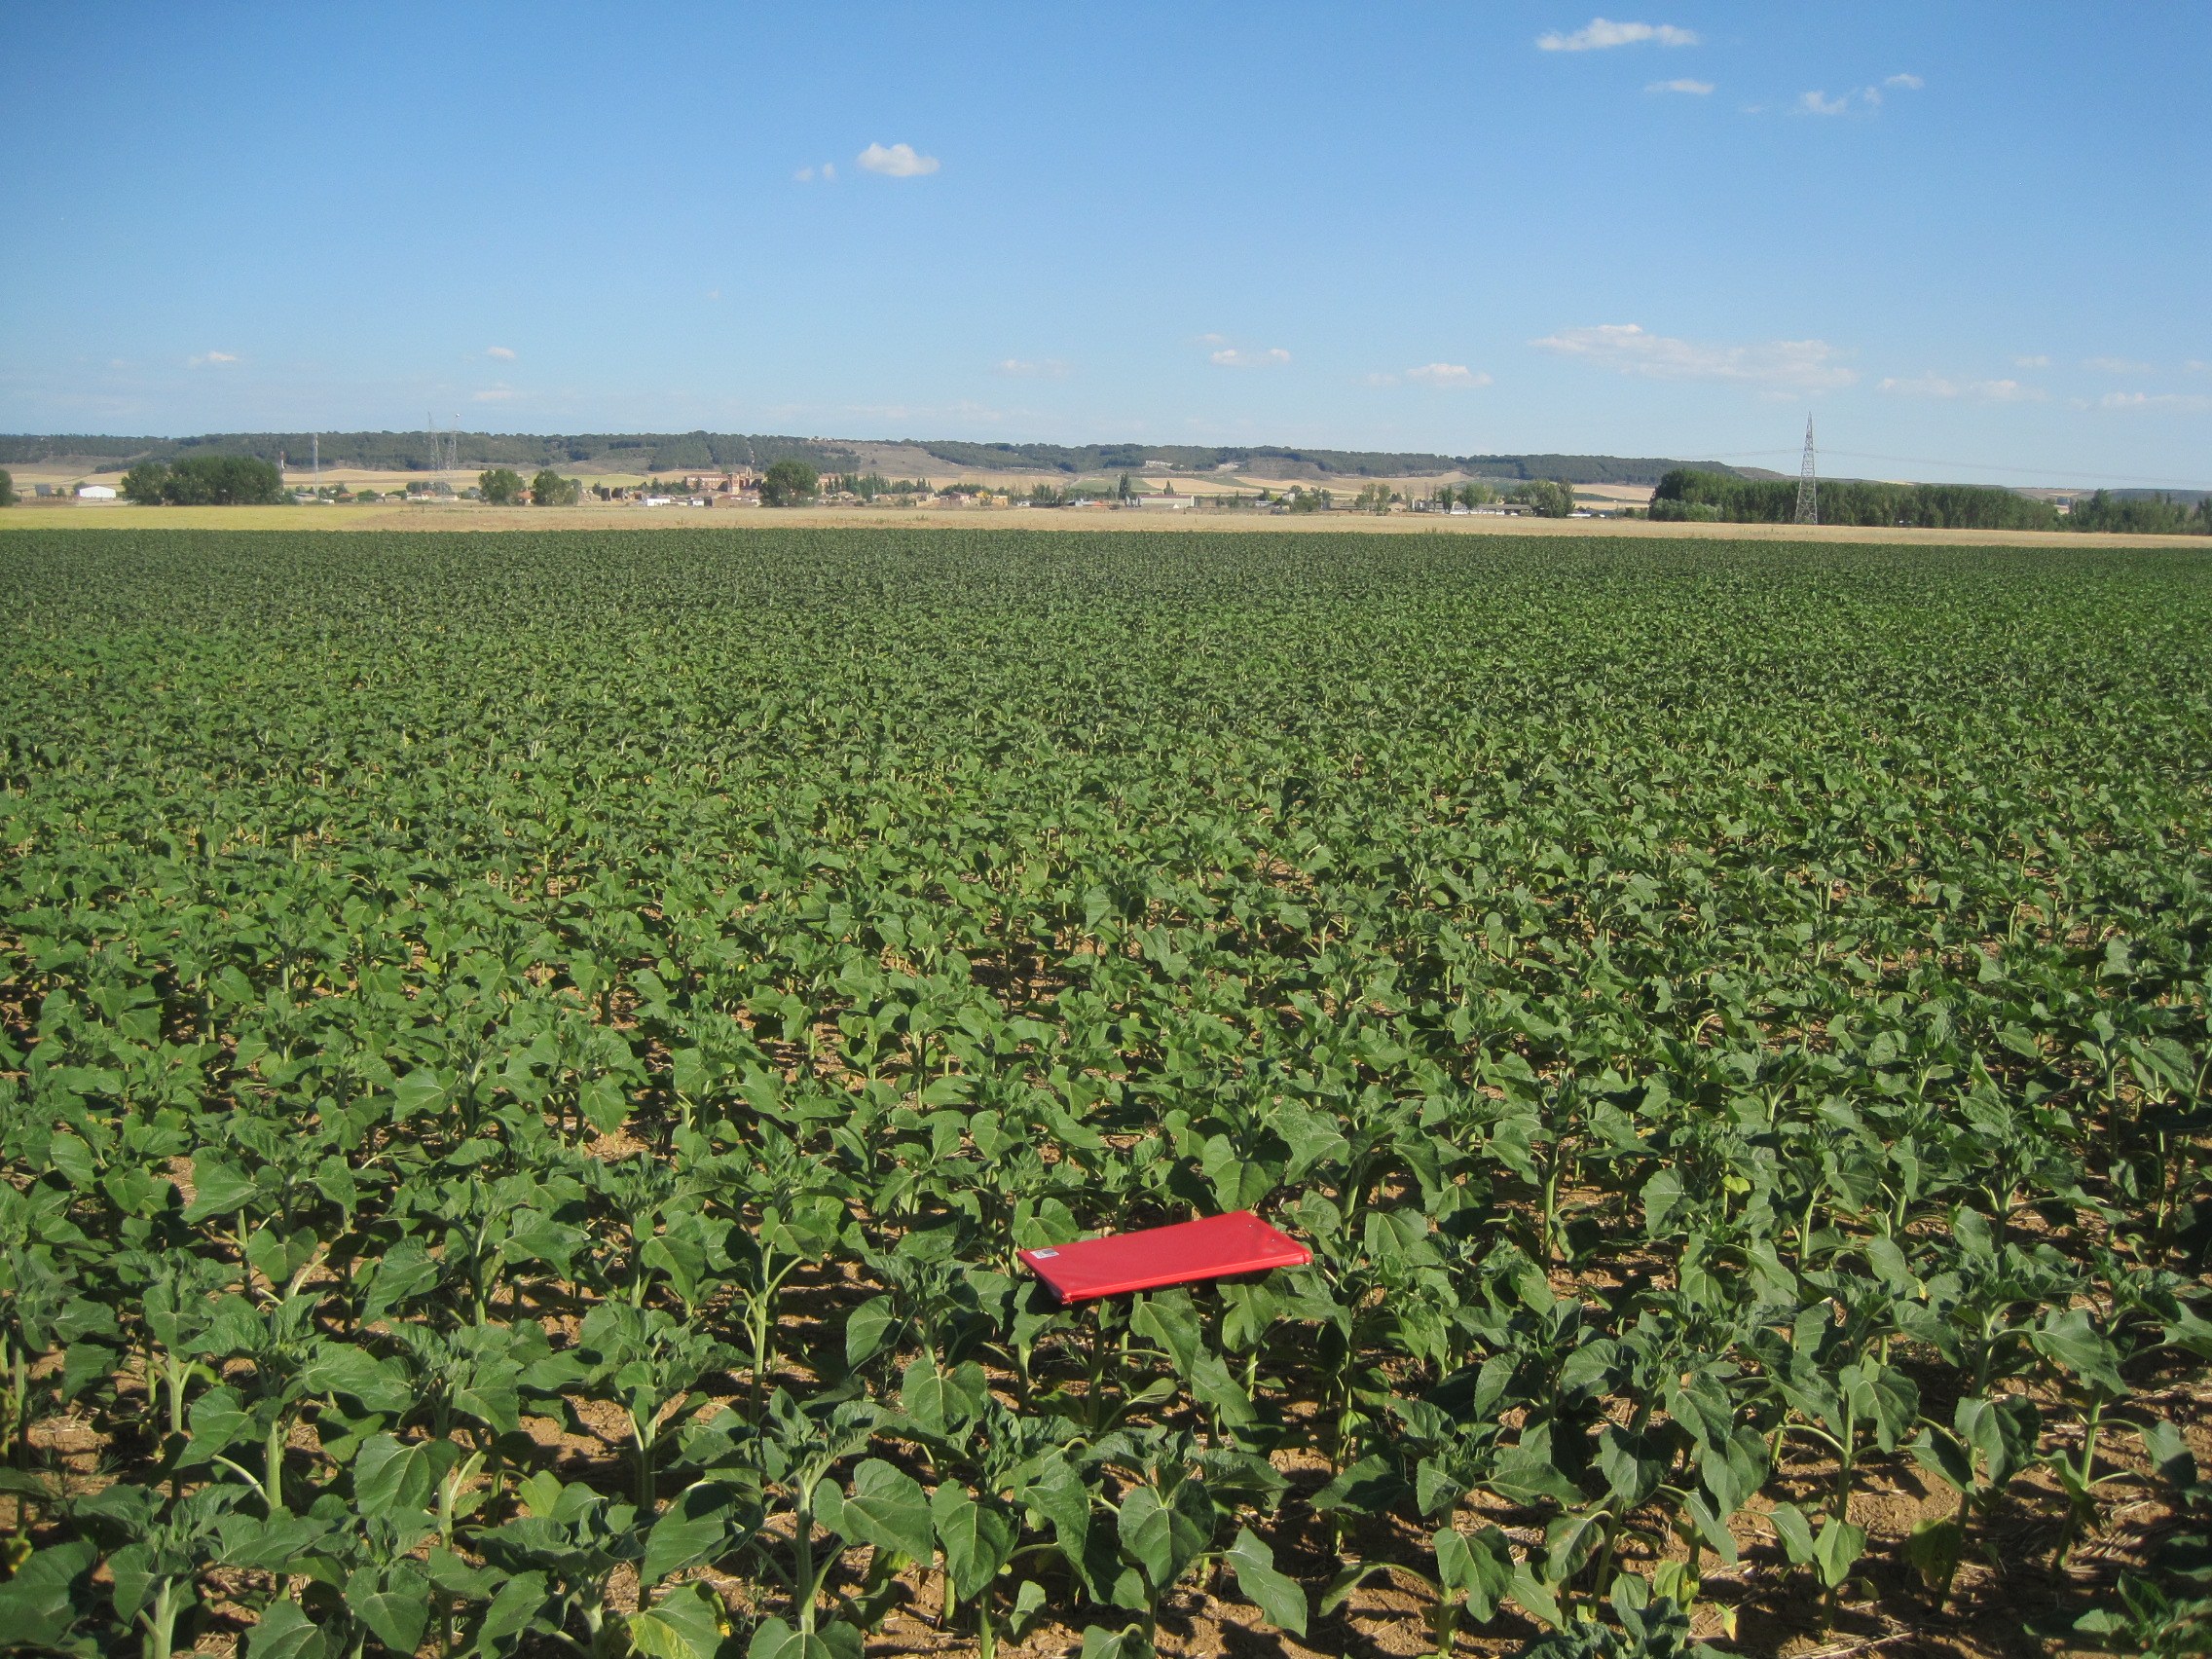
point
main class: Cropland
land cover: Sunflower
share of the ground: > 75 %
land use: Agriculture (excluding fallow land and kitchen gardens)
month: June
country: ES
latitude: 41.7917
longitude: -5.2059
